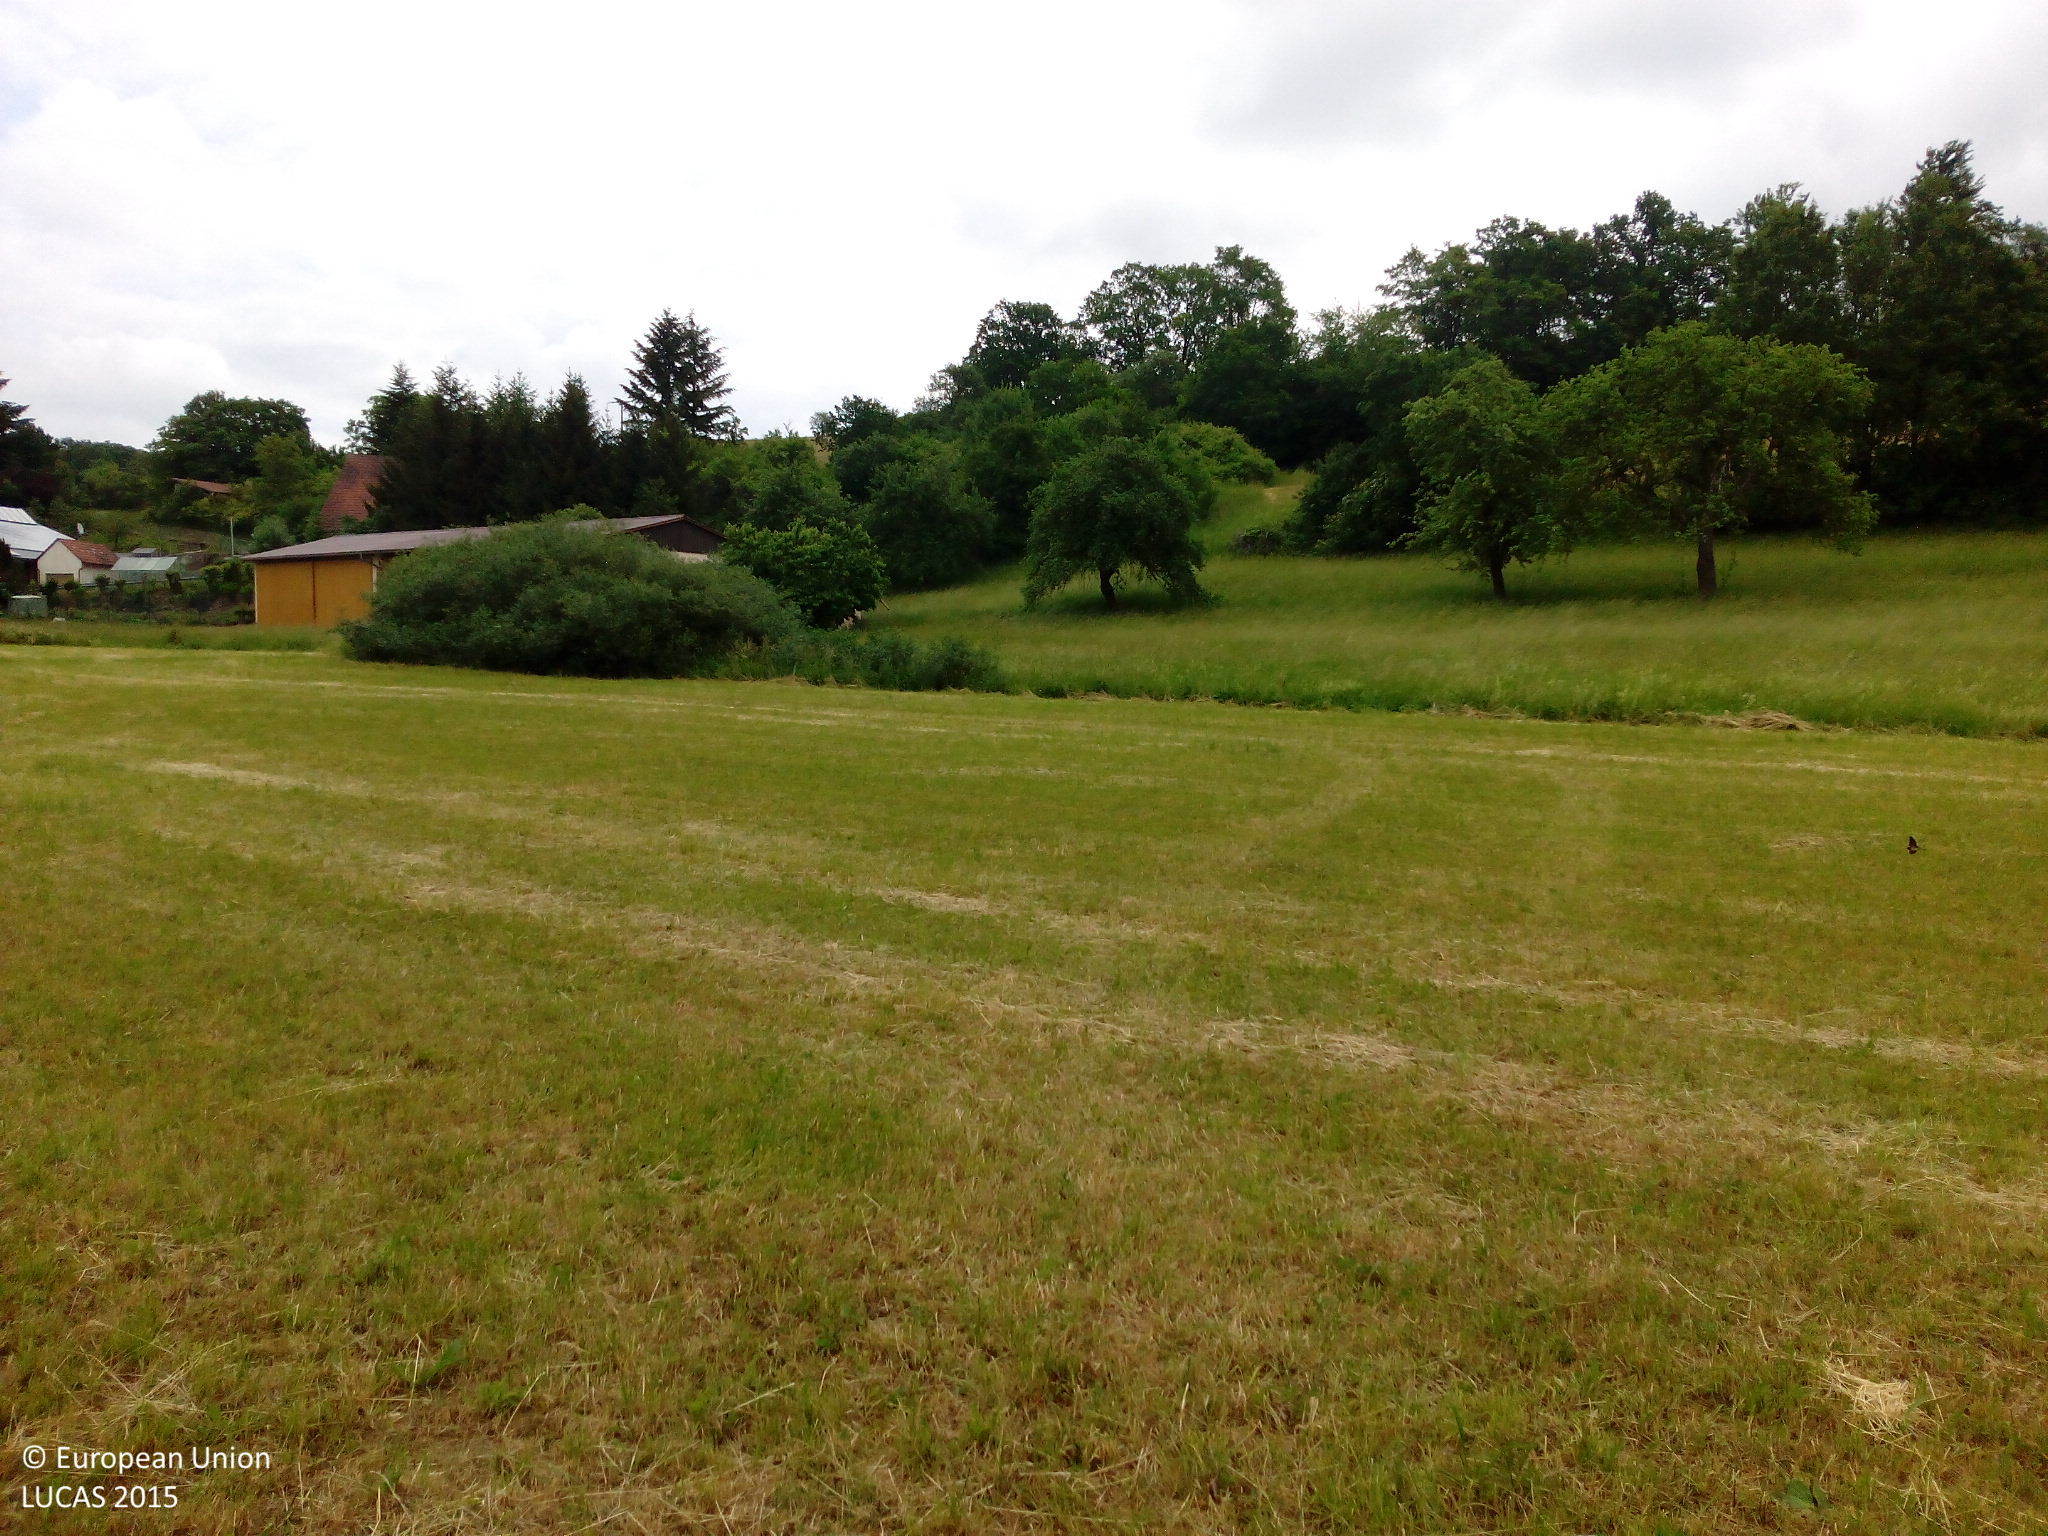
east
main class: Grassland
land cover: Grassland without tree/shrub cover
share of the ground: > 75 %
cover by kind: herbaceous plants 100 %
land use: Agriculture (excluding fallow land and kitchen gardens)
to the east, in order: Grassland without tree/shrub cover; Single bushes/trees; Ditches and canals; Grassland without tree/shrub cover; Tracks; Grassland without tree/shrub cover; Artificial constructions in urban areas; Grassland without tree/shrub cover; Apple fruit; Abandoned hedges; Grass margins; Paved roads, cycling and walking lanes; Grass margins; Ditches and canals; Grass margins; Broadleaved woodland; Grassland without tree/shrub cover; Broadleaved woodland; Grassland without tree/shrub cover
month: June
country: DE
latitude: 50.1120
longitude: 10.2656
